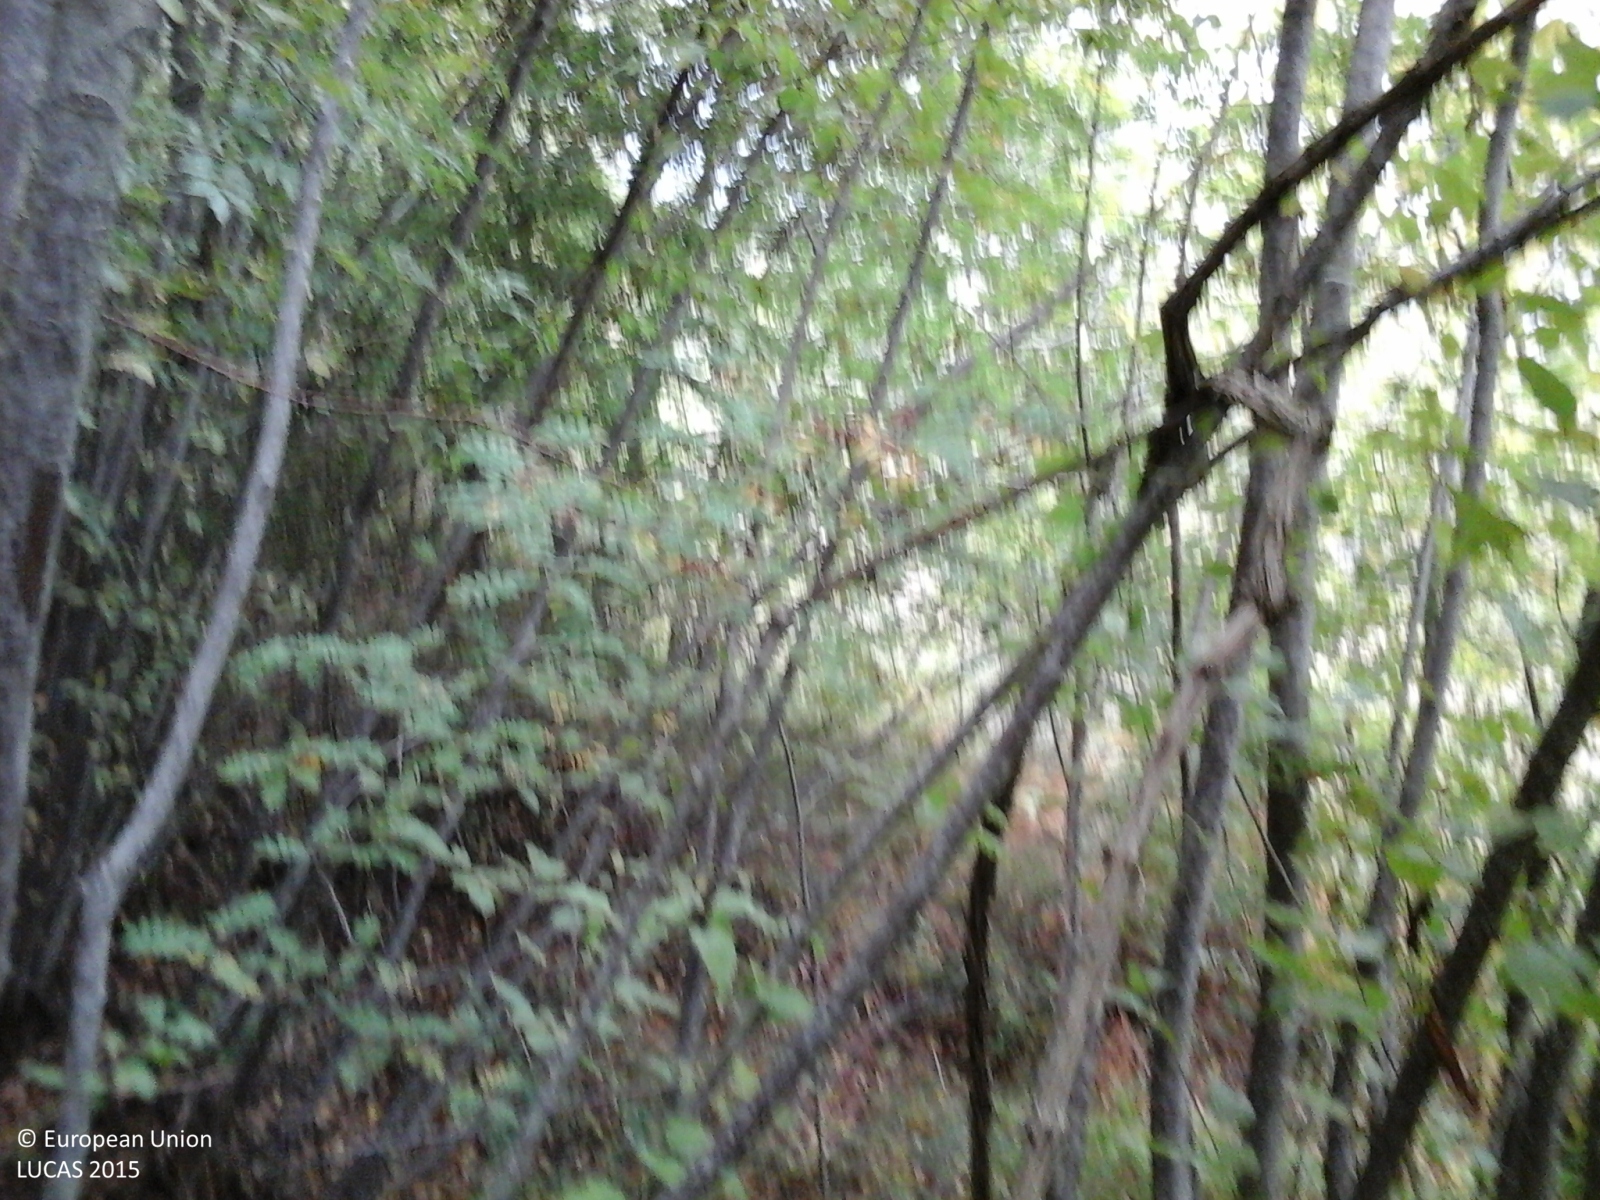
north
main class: Woodland
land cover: Broadleaved woodland
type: thermophilous deciduous forest
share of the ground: > 75 %
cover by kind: broadleaved forest trees 100 %
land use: Forestry
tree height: > 5 m
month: September
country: IT
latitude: 43.4696
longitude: 12.6014
